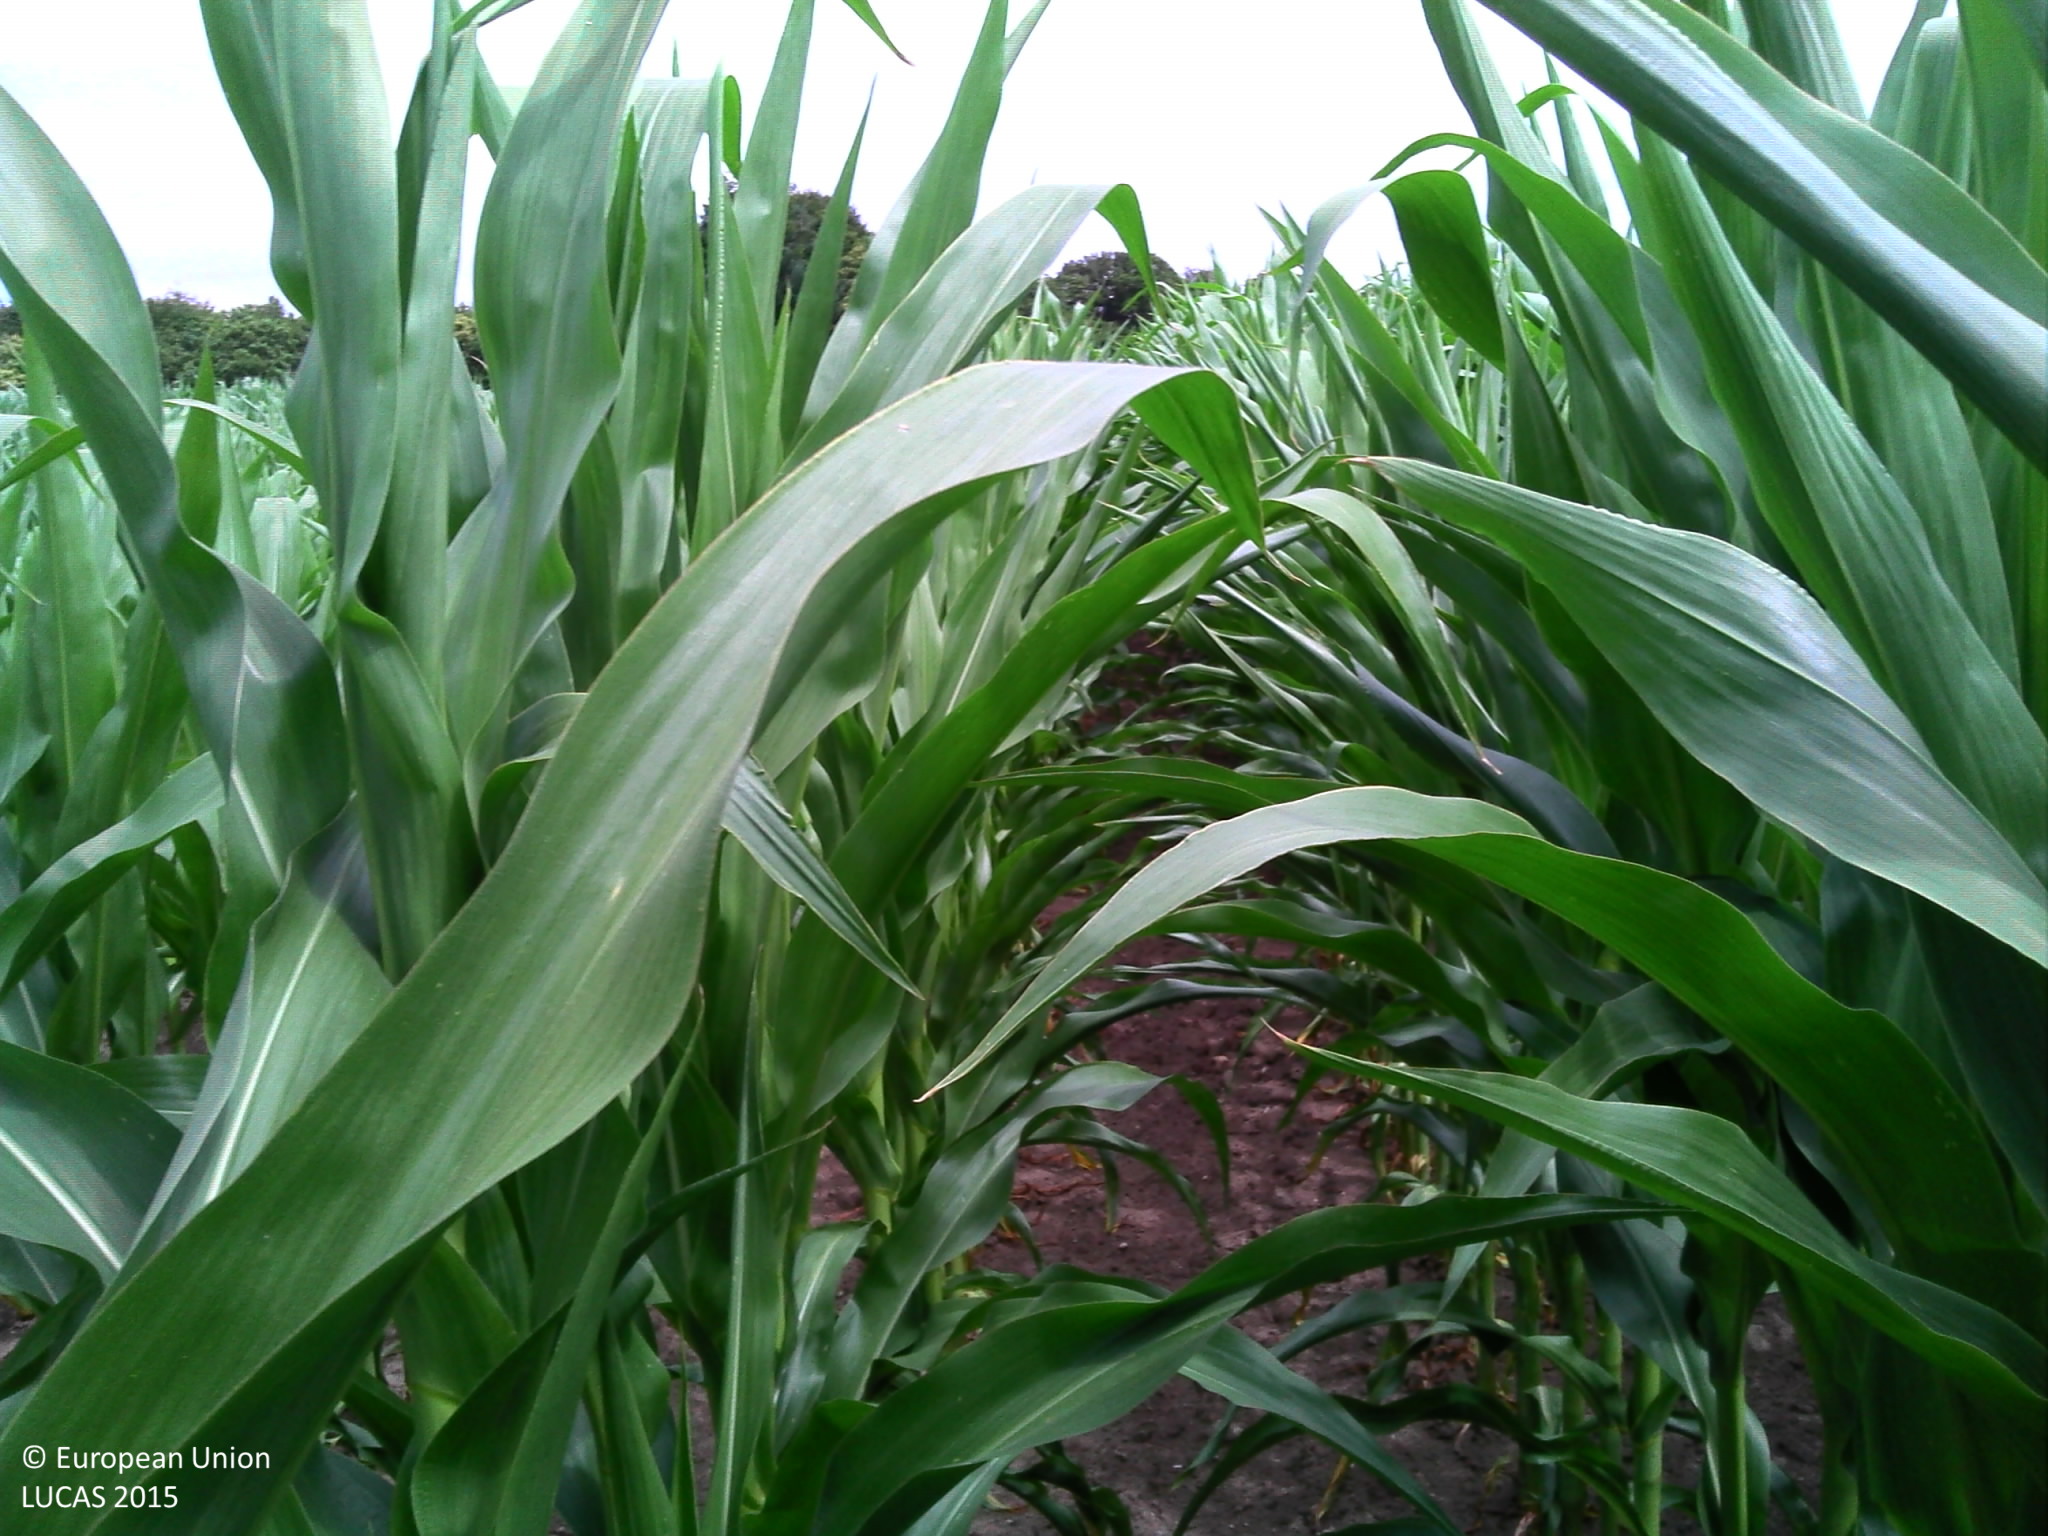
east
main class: Cropland
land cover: Maize
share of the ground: > 75 %
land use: Agriculture (excluding fallow land and kitchen gardens)
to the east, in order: Maize; Broadleaved woodland; Tracks; Maize
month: July
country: FR
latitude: 47.8377
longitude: -3.2586
